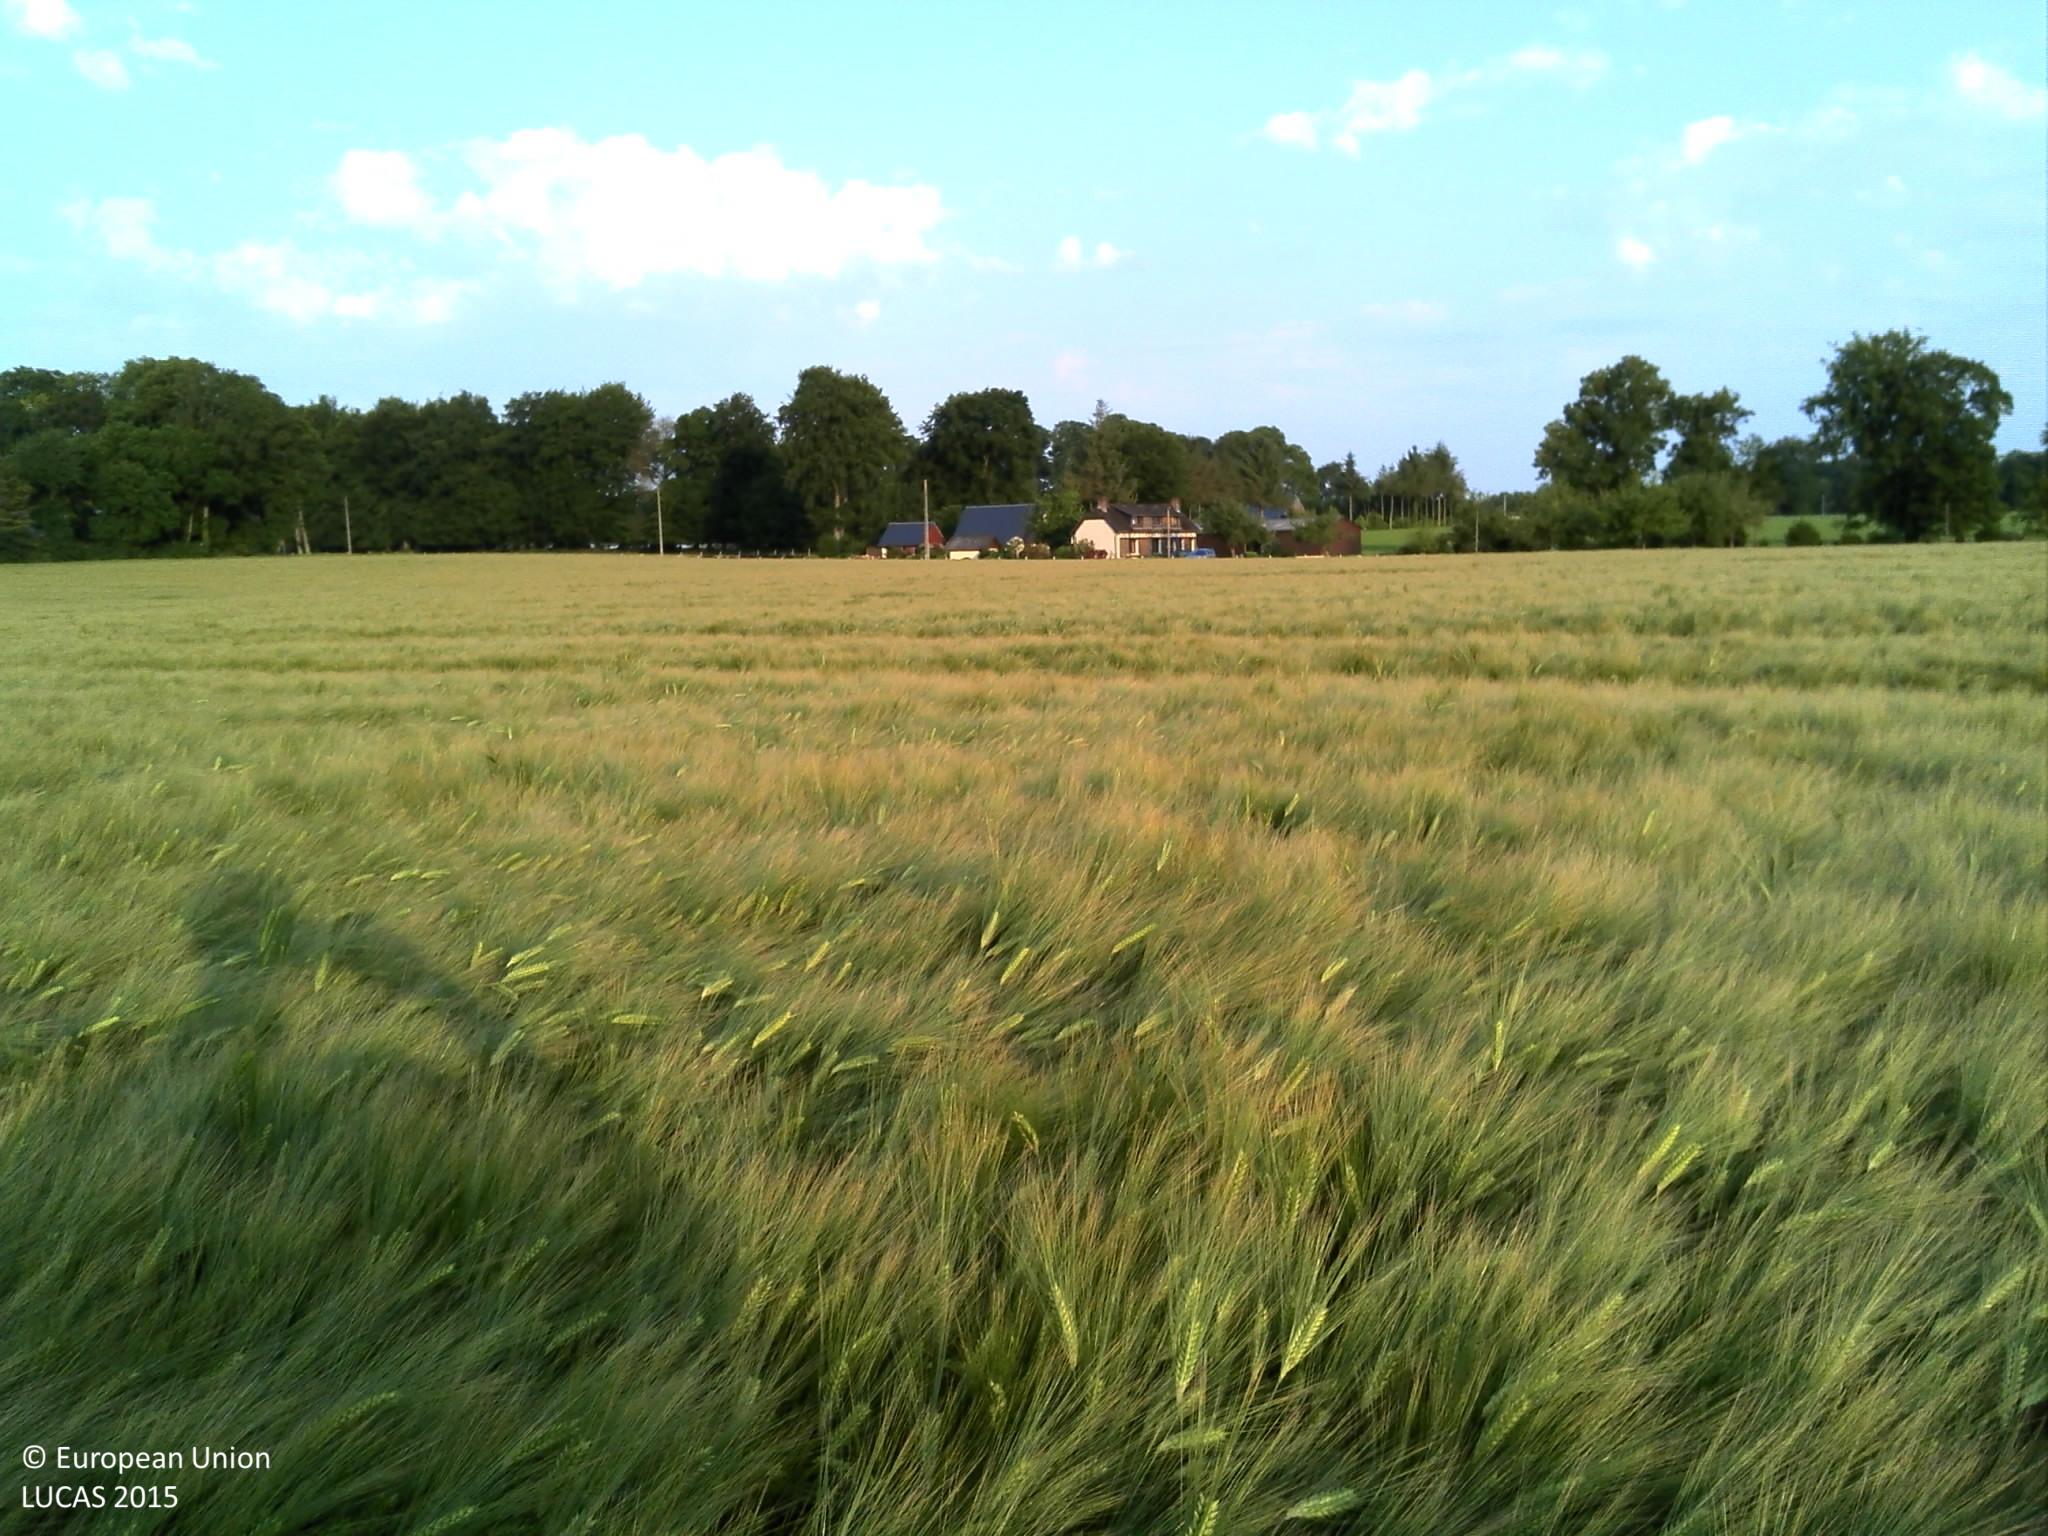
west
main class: Cropland
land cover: Barley
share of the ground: > 75 %
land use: Agriculture (excluding fallow land and kitchen gardens)
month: June
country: FR
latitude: 49.6703
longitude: 1.0685
